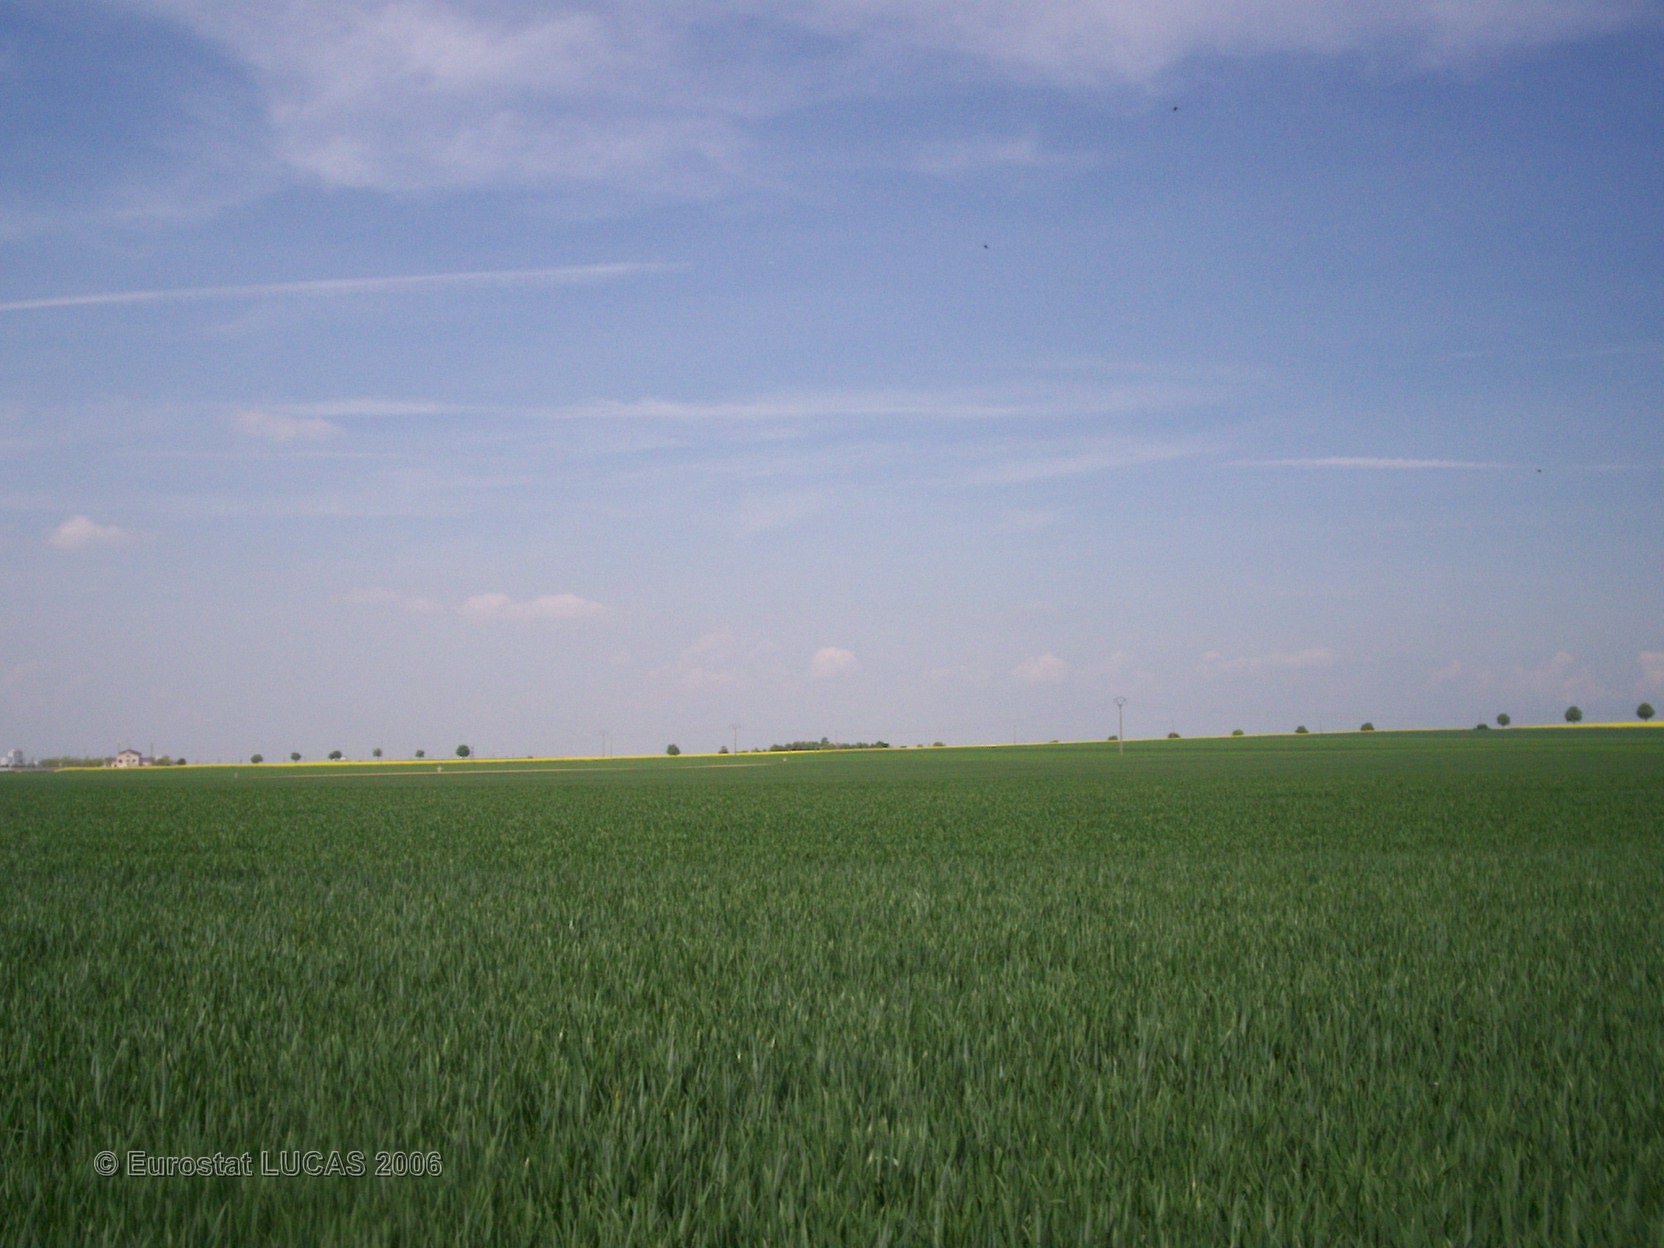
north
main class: Cropland
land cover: Common wheat
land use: Agriculture (excluding fallow land and kitchen gardens)
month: May
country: FR
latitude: 48.9296
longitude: 4.4138
